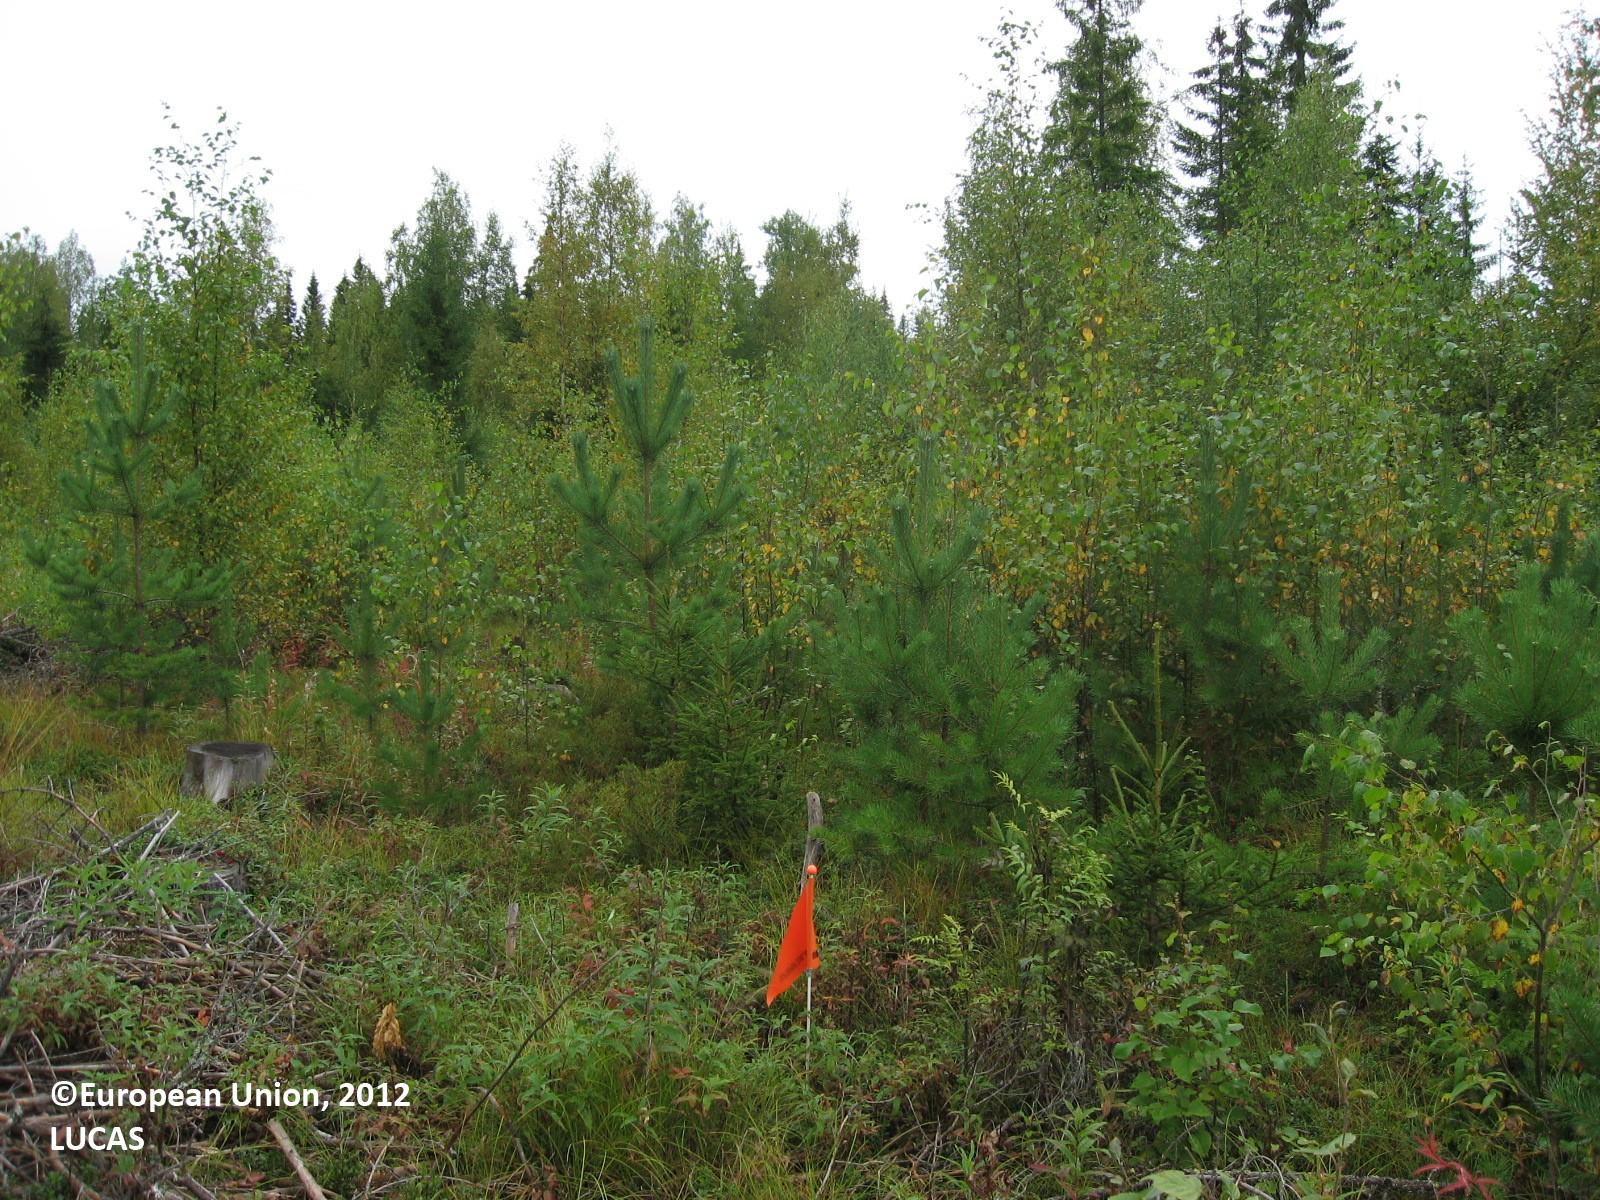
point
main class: Woodland
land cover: Pine dominated mixed woodland
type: boreal forest
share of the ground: 50 - 75 %
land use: Forestry
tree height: < 5 m
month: August
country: FI
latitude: 61.4877
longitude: 24.8095
